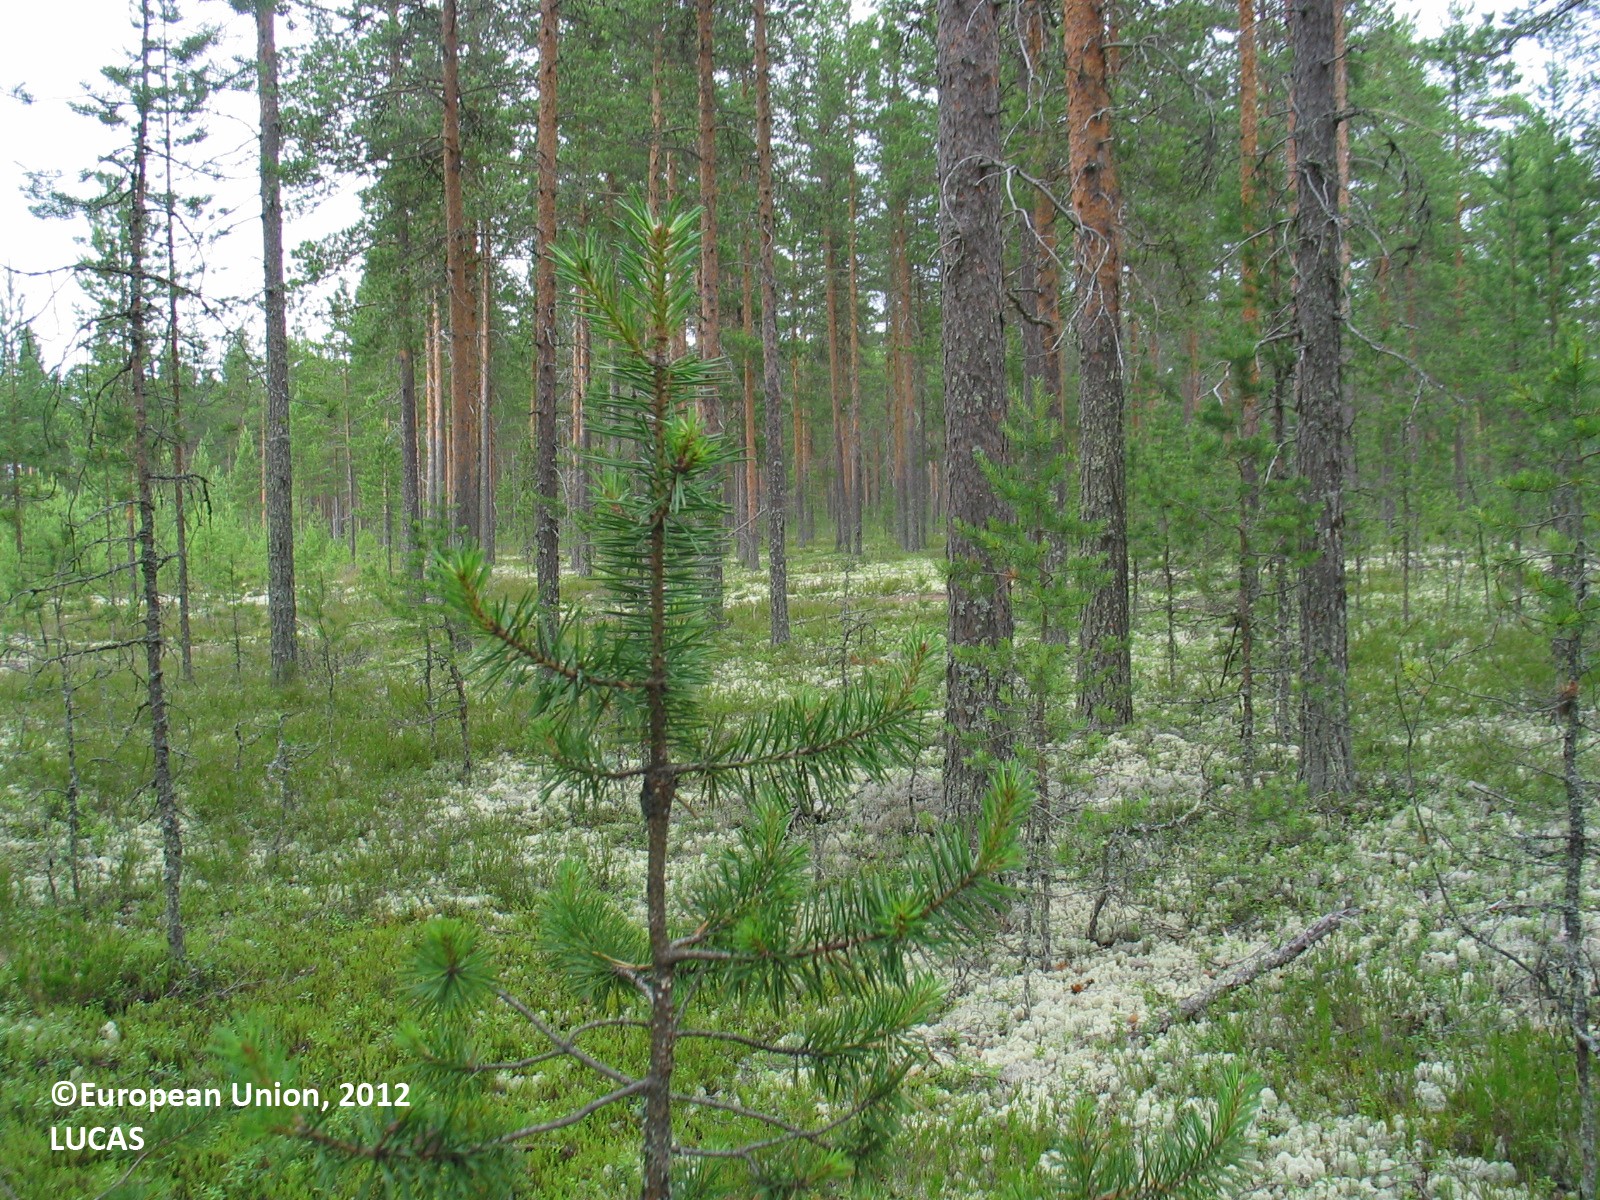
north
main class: Woodland
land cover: Pine dominated coniferous woodland
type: boreal forest
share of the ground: 50 - 75 %
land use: Forestry
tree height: > 5 m
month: July
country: FI
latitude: 64.6336
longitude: 26.3646
